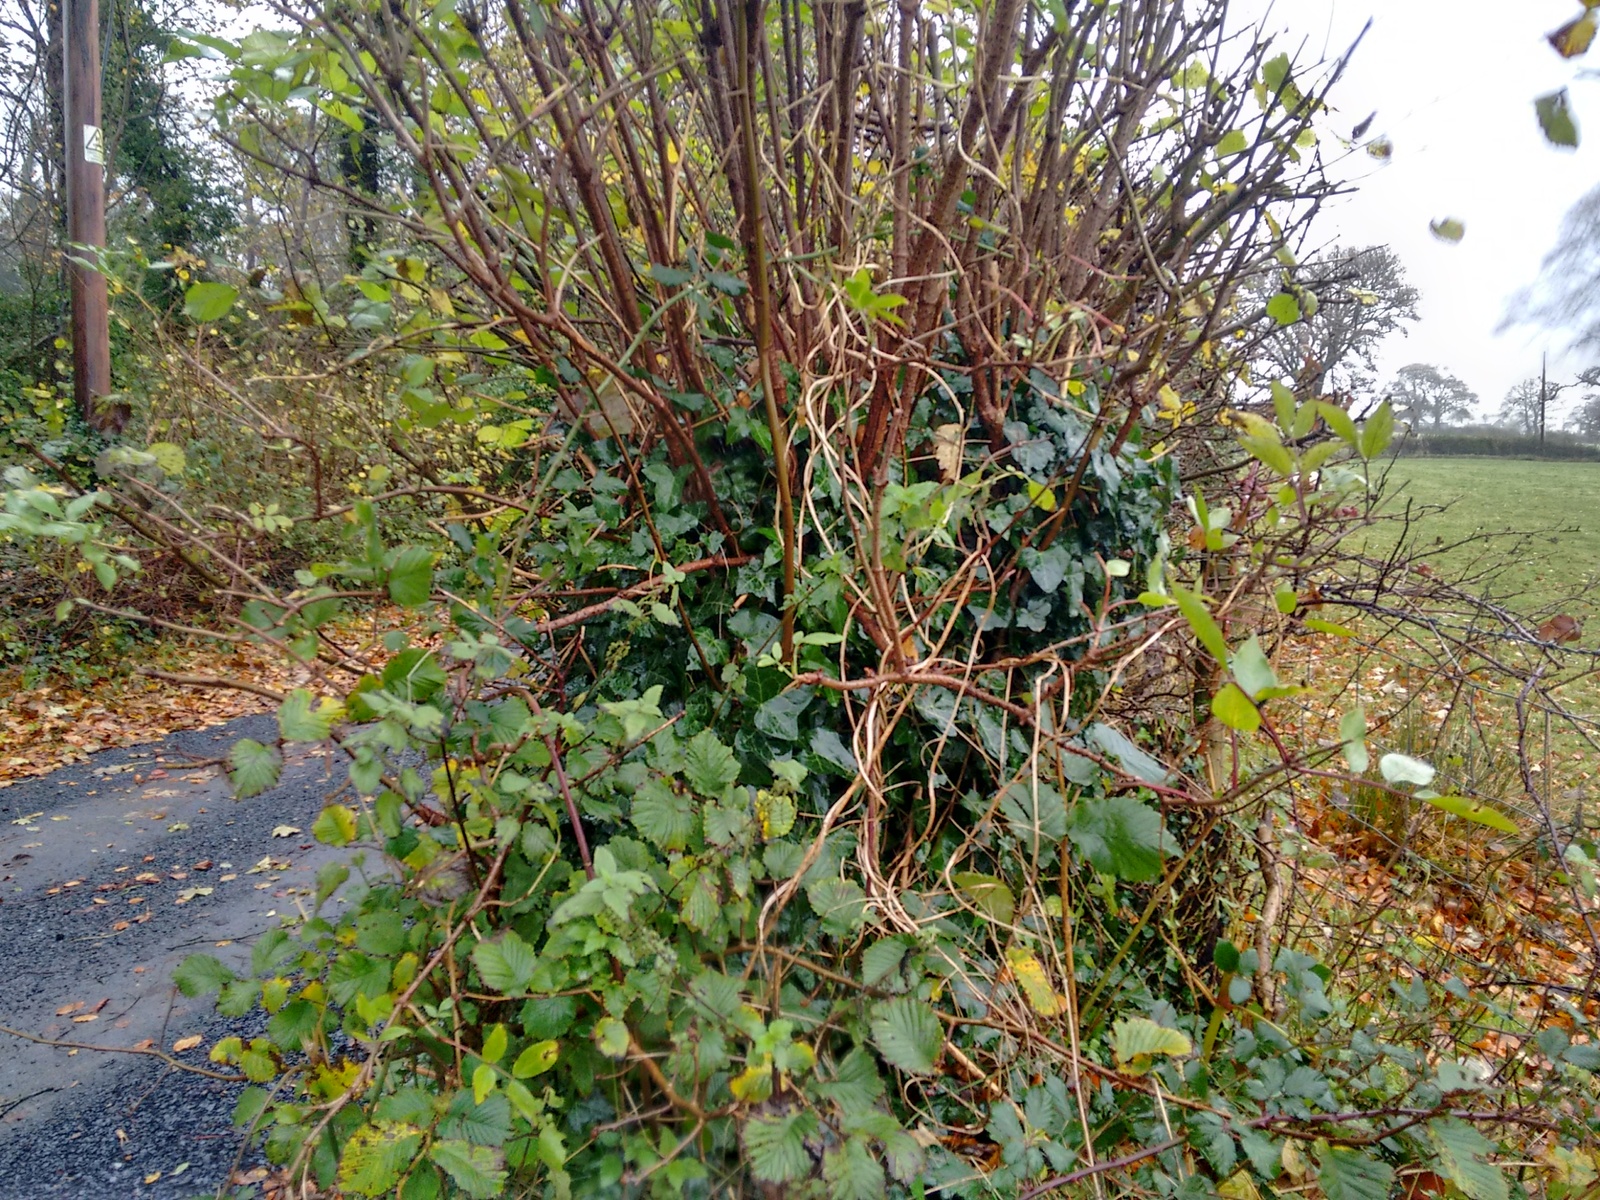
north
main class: Grassland
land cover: Grassland without tree/shrub cover
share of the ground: > 75 %
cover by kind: herbaceous plants 100 %
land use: Agriculture (excluding fallow land and kitchen gardens)
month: November
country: GB
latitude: 52.9193
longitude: -4.0916
